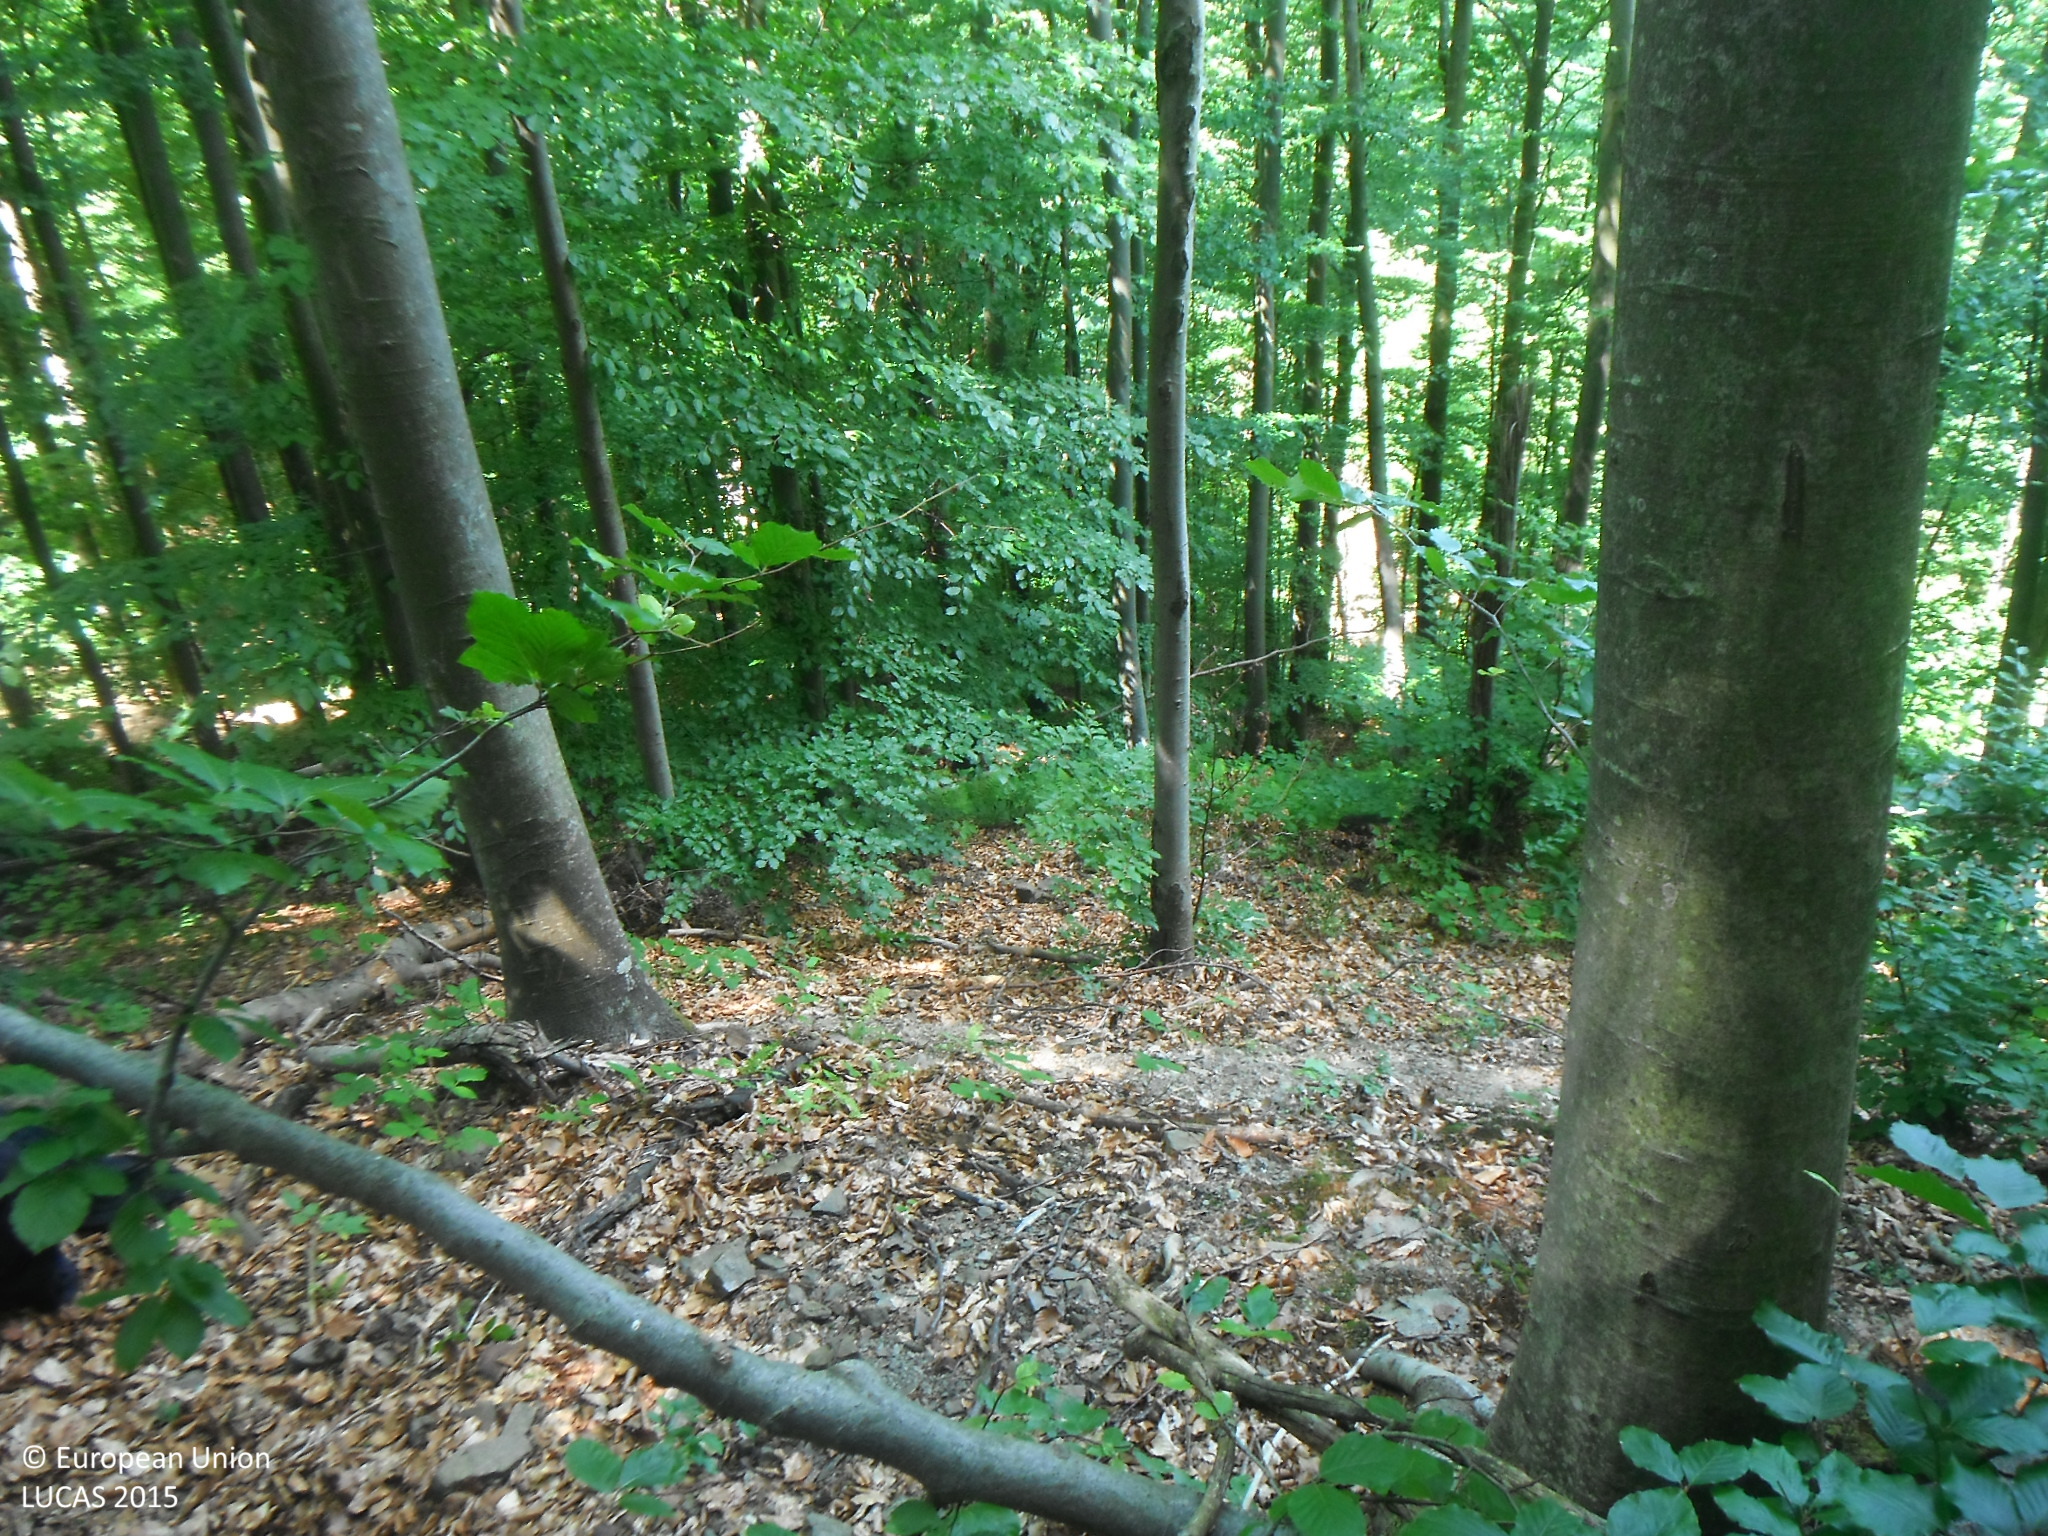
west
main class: Woodland
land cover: Broadleaved woodland
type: beech forest
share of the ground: > 75 %
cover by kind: broadleaved forest trees 100 %
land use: Forestry
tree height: > 5 m
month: July
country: SK
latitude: 48.9972
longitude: 22.3762
